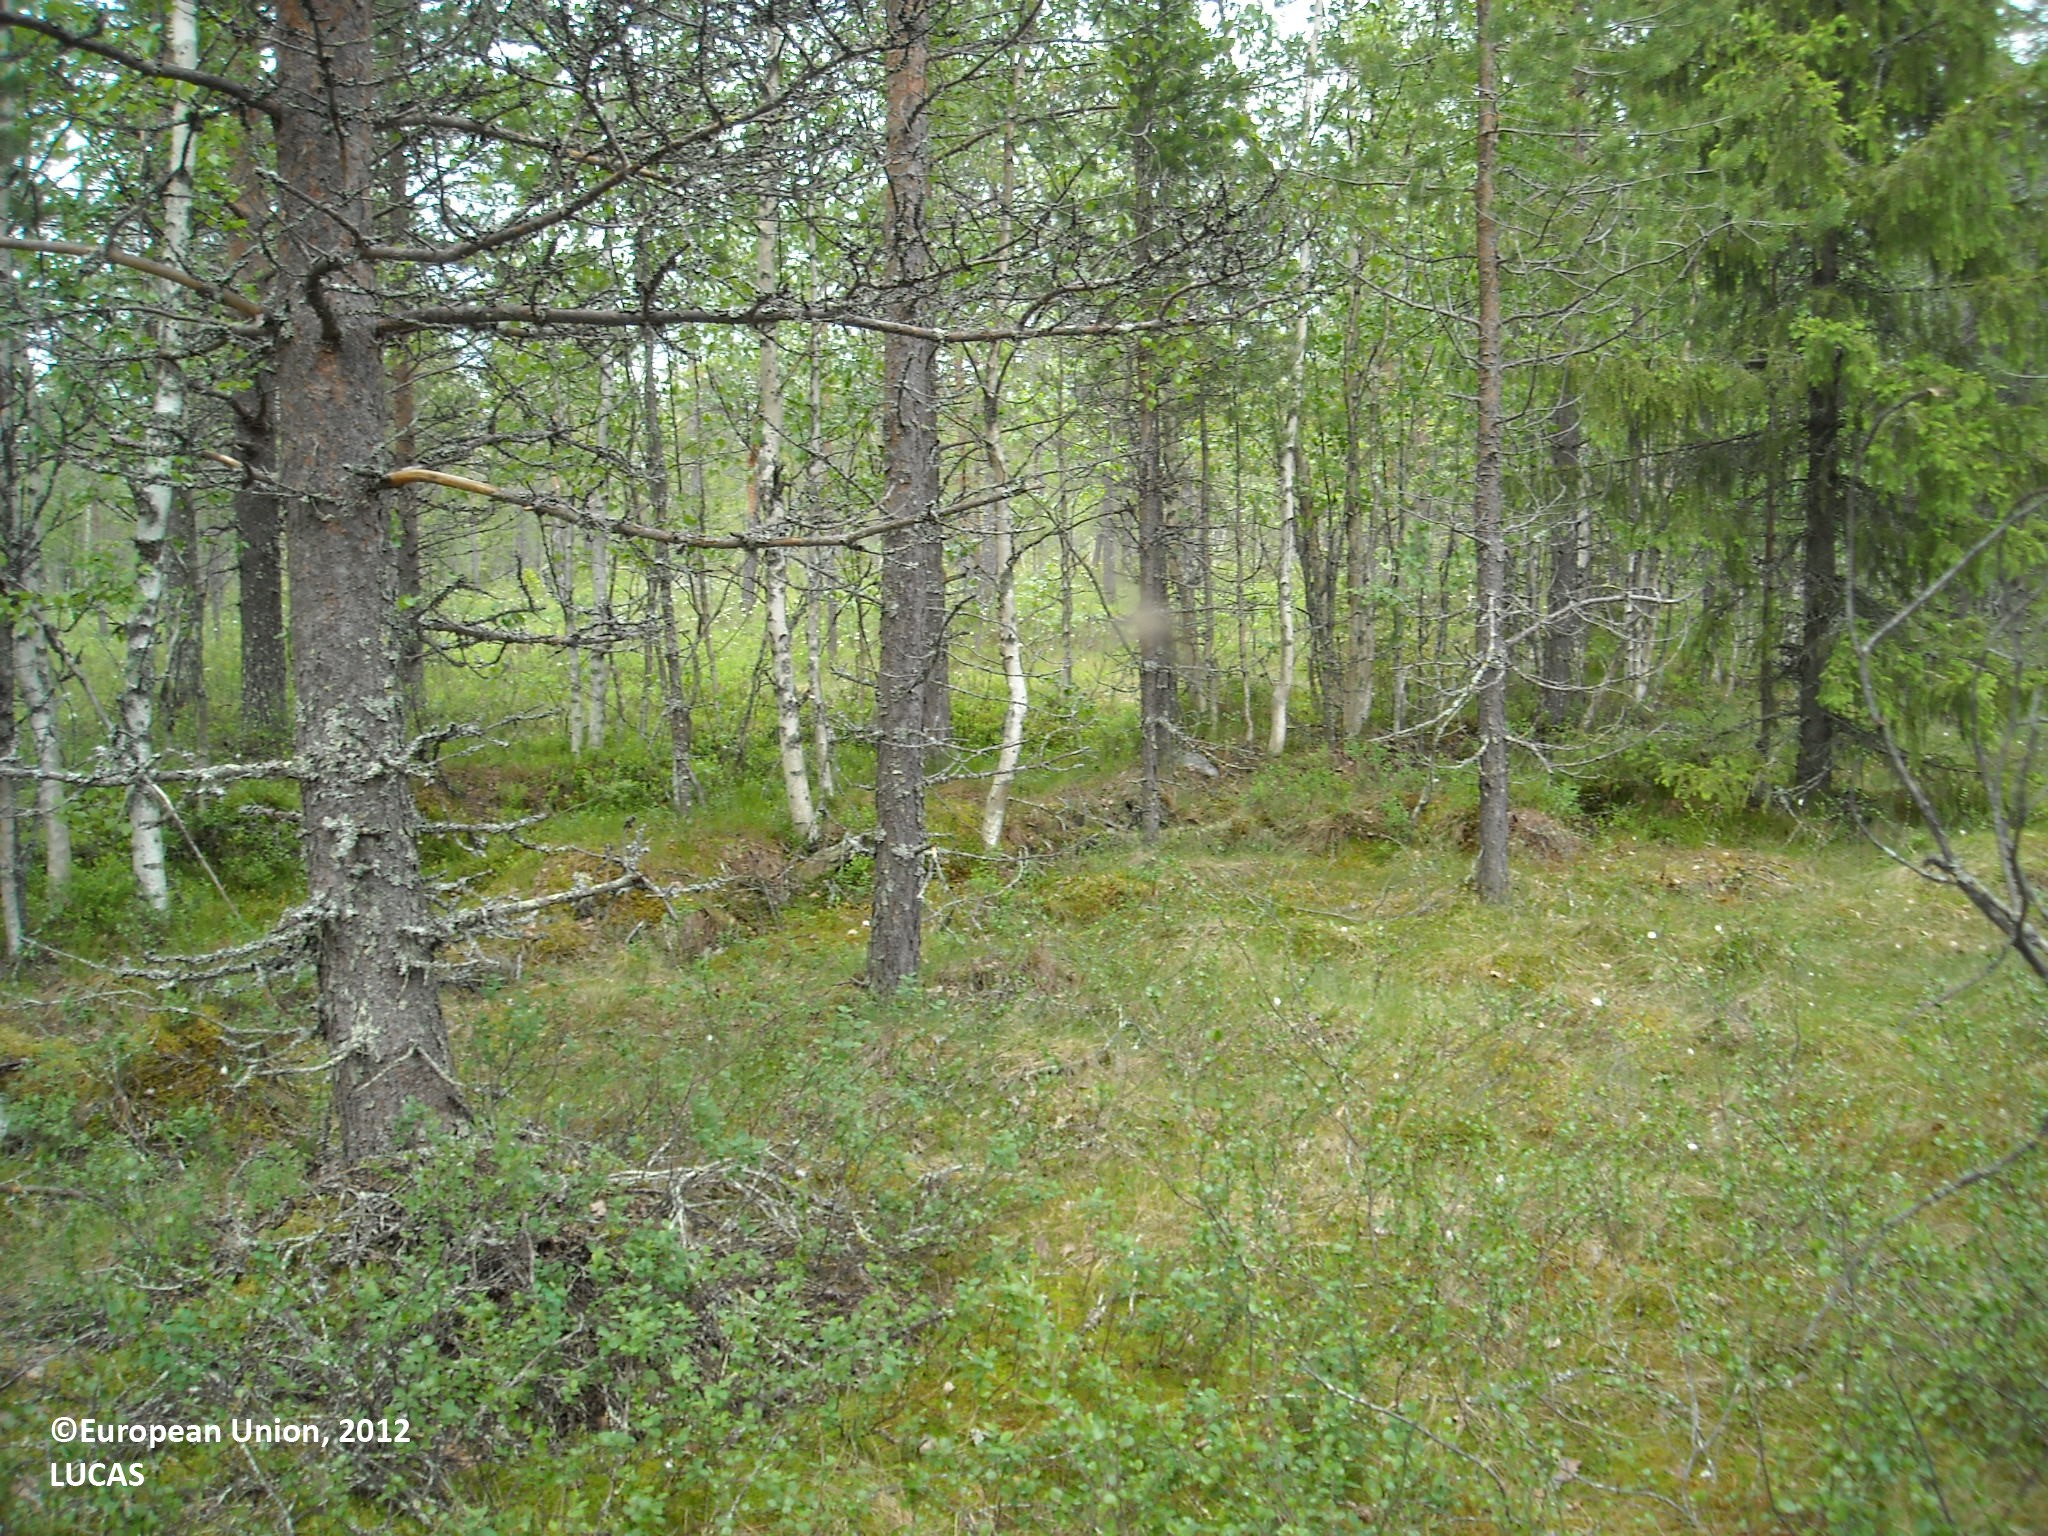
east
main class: Woodland
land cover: Pine dominated coniferous woodland
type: mire and swamp forests
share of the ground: 25 - 50 %
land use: Forestry
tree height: > 5 m
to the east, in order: Pine dominated coniferous woodland; Pine dominated mixed woodland; Ditches and canals; Pine dominated mixed woodland; Ditches and canals; Pine dominated mixed woodland; Pine dominated coniferous woodland; Pine dominated mixed woodland; Ditches and canals; Pine dominated mixed woodland; Pine dominated coniferous woodland
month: June
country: FI
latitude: 64.7650
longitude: 27.3957
